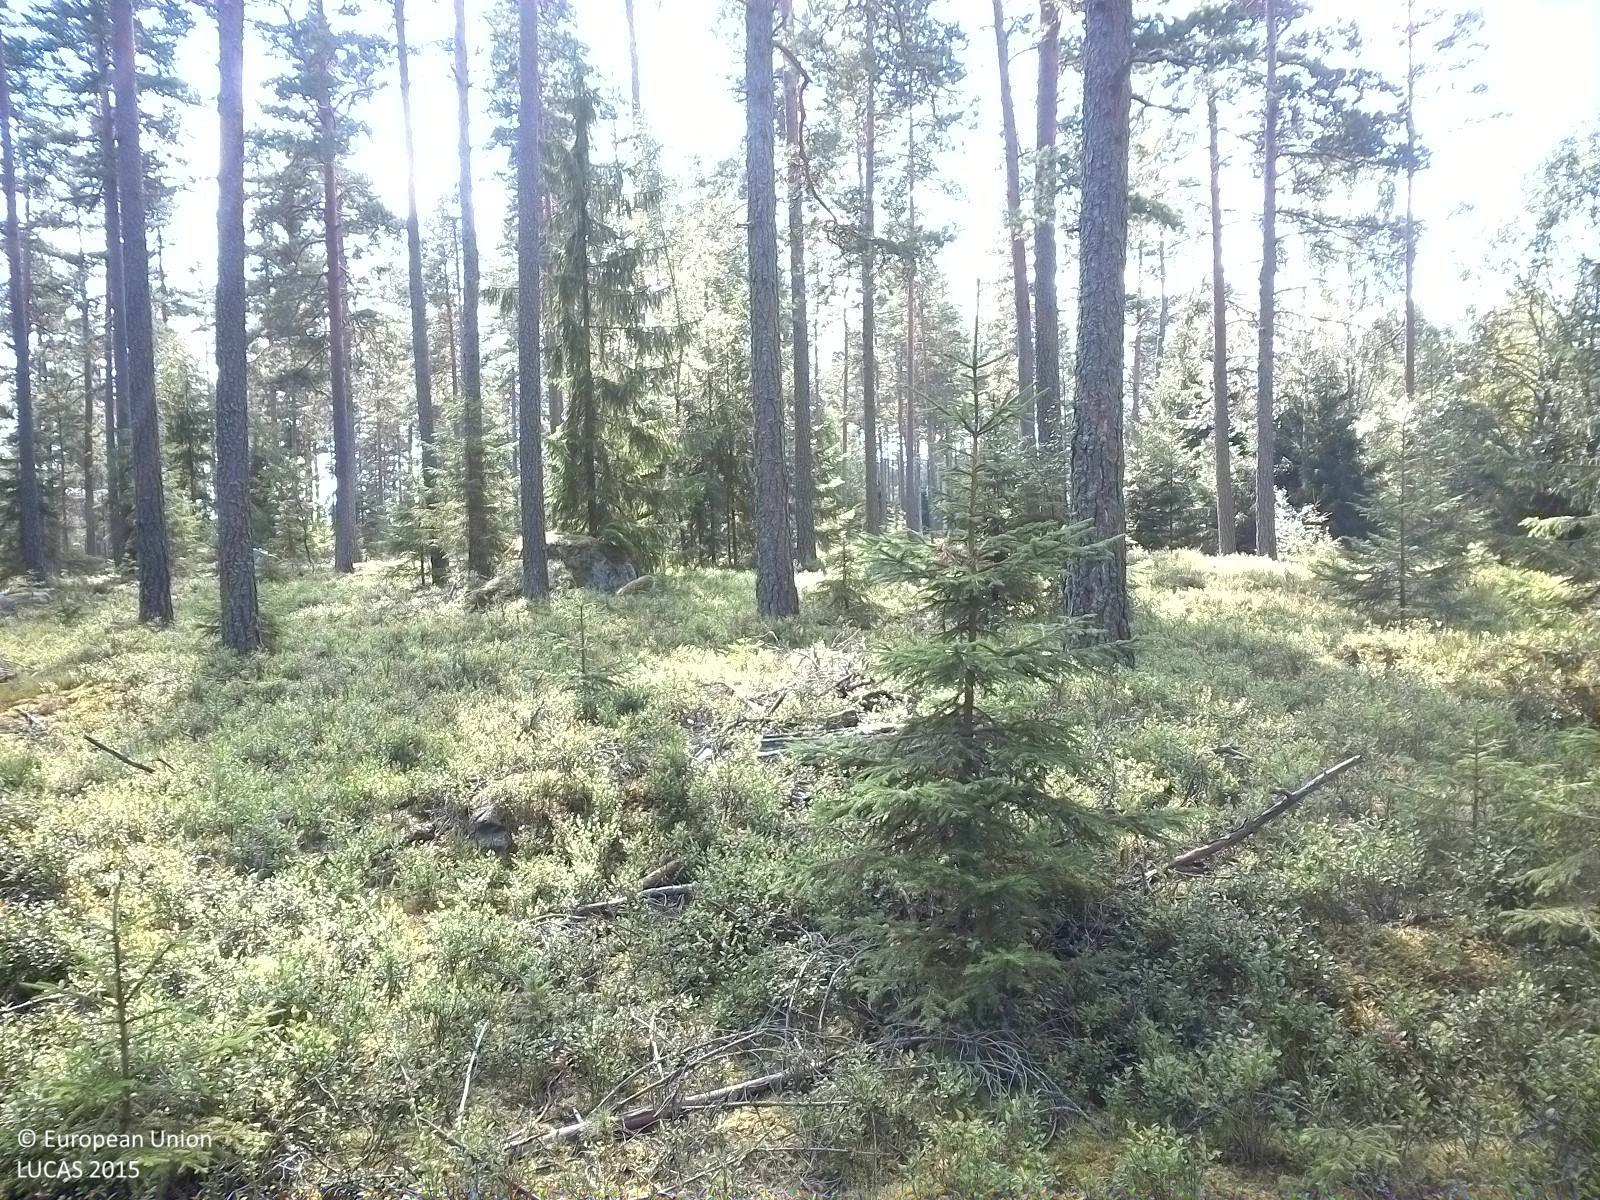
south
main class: Woodland
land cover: Pine dominated coniferous woodland
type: boreal forest
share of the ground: 25 - 50 %
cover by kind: herbaceous plants 40 %, coniferous forest trees 30 %, lichens and mosses 30 %
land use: Forestry
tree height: > 5 m
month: August
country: SE
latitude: 58.8856
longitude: 15.4235
